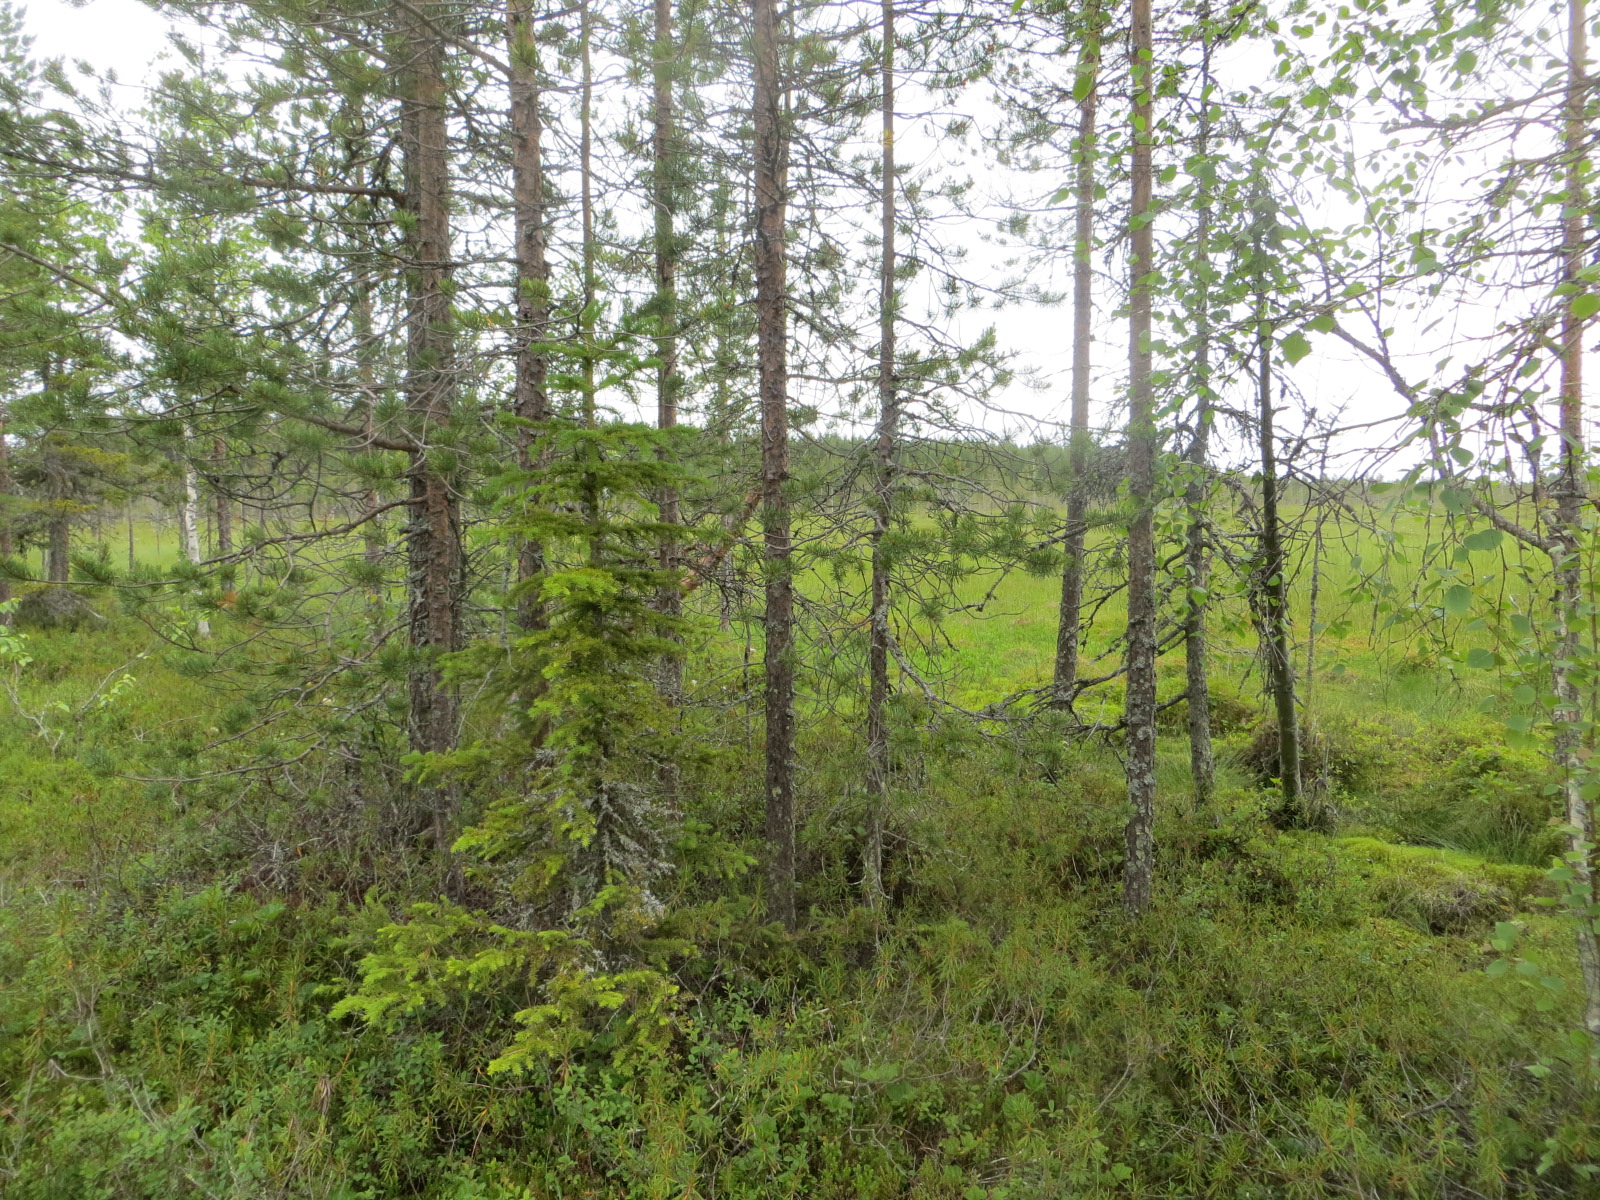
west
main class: Woodland
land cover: Pine dominated coniferous woodland
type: boreal forest
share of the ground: > 75 %
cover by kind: coniferous forest trees 75 %, shrubs 20 %, broadleaved forest trees 5 %
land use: Forestry
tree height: > 5 m
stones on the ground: 25 - 50 %
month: July
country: FI
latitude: 65.5765
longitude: 25.8416
